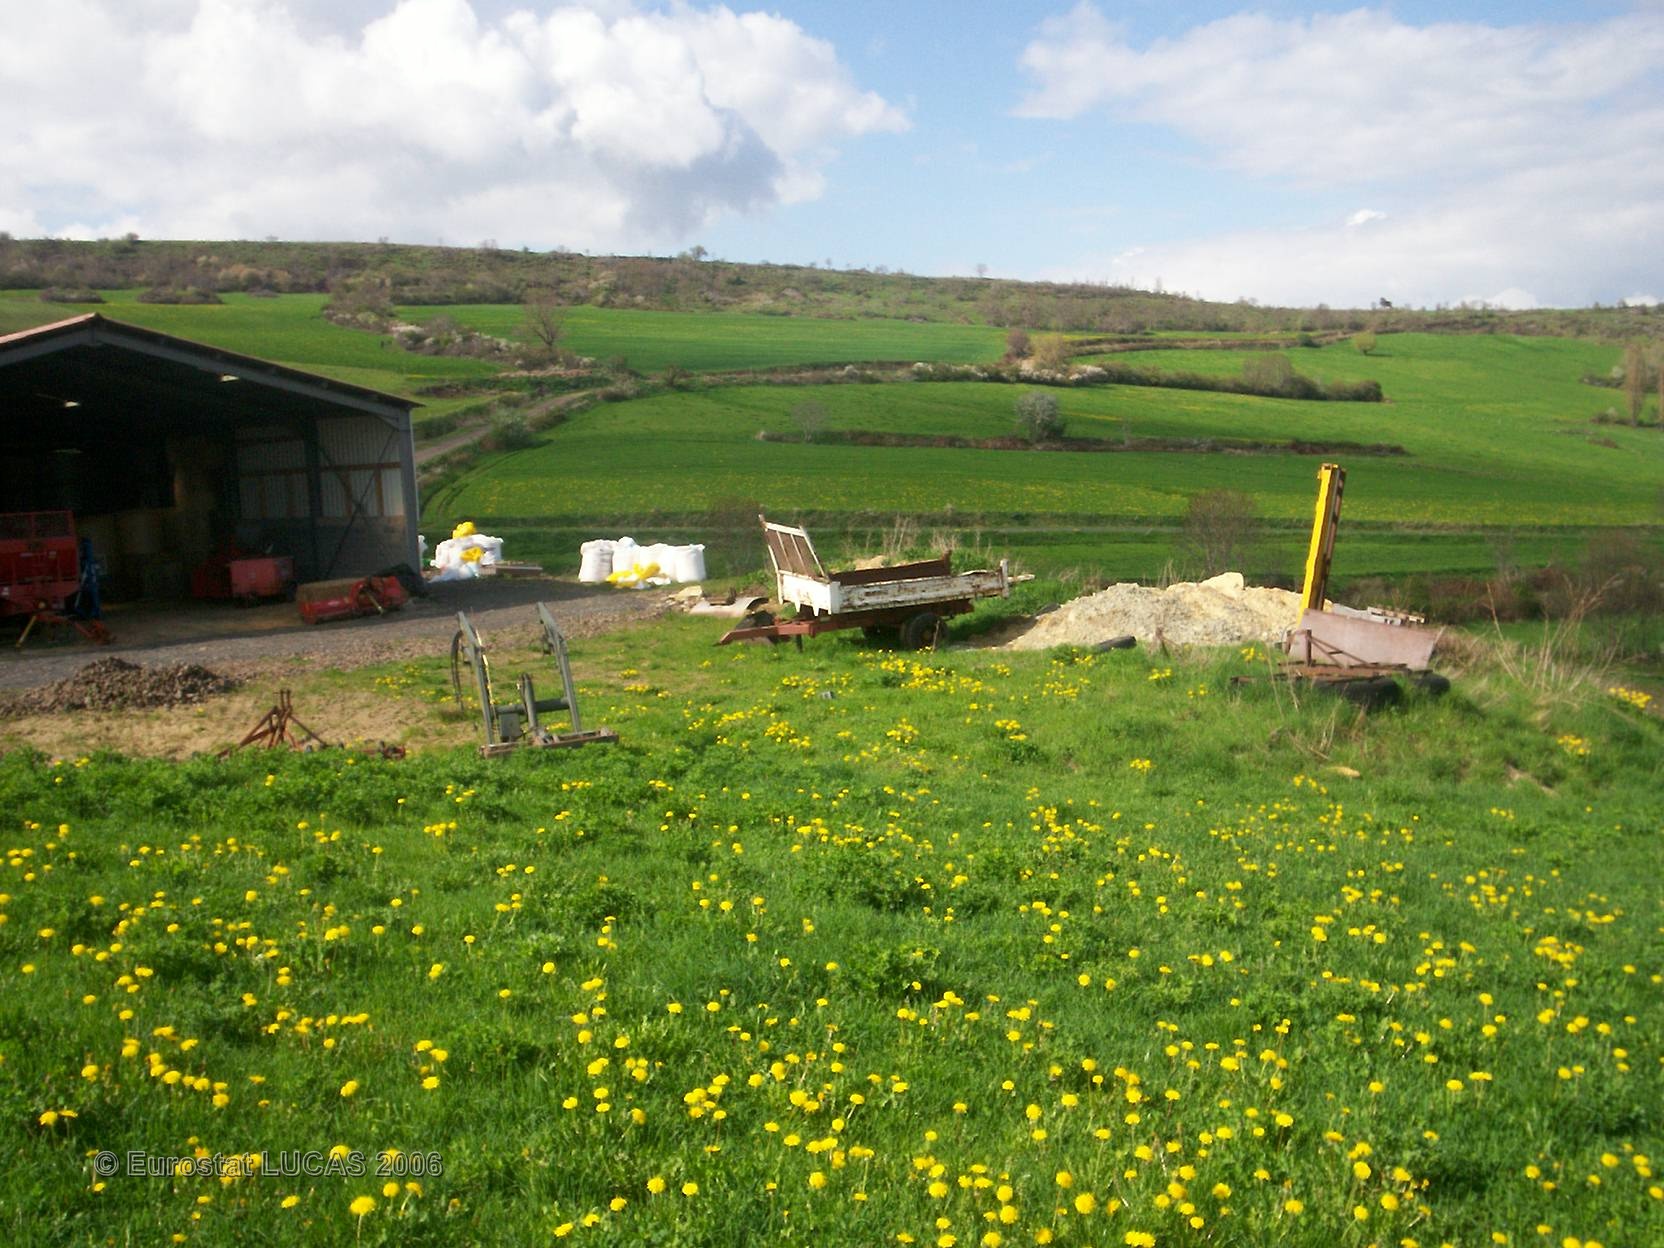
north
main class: Grassland
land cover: Grassland without tree/shrub cover
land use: Agriculture (excluding fallow land and kitchen gardens)
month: April
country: FR
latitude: 45.4257
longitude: 3.1377
